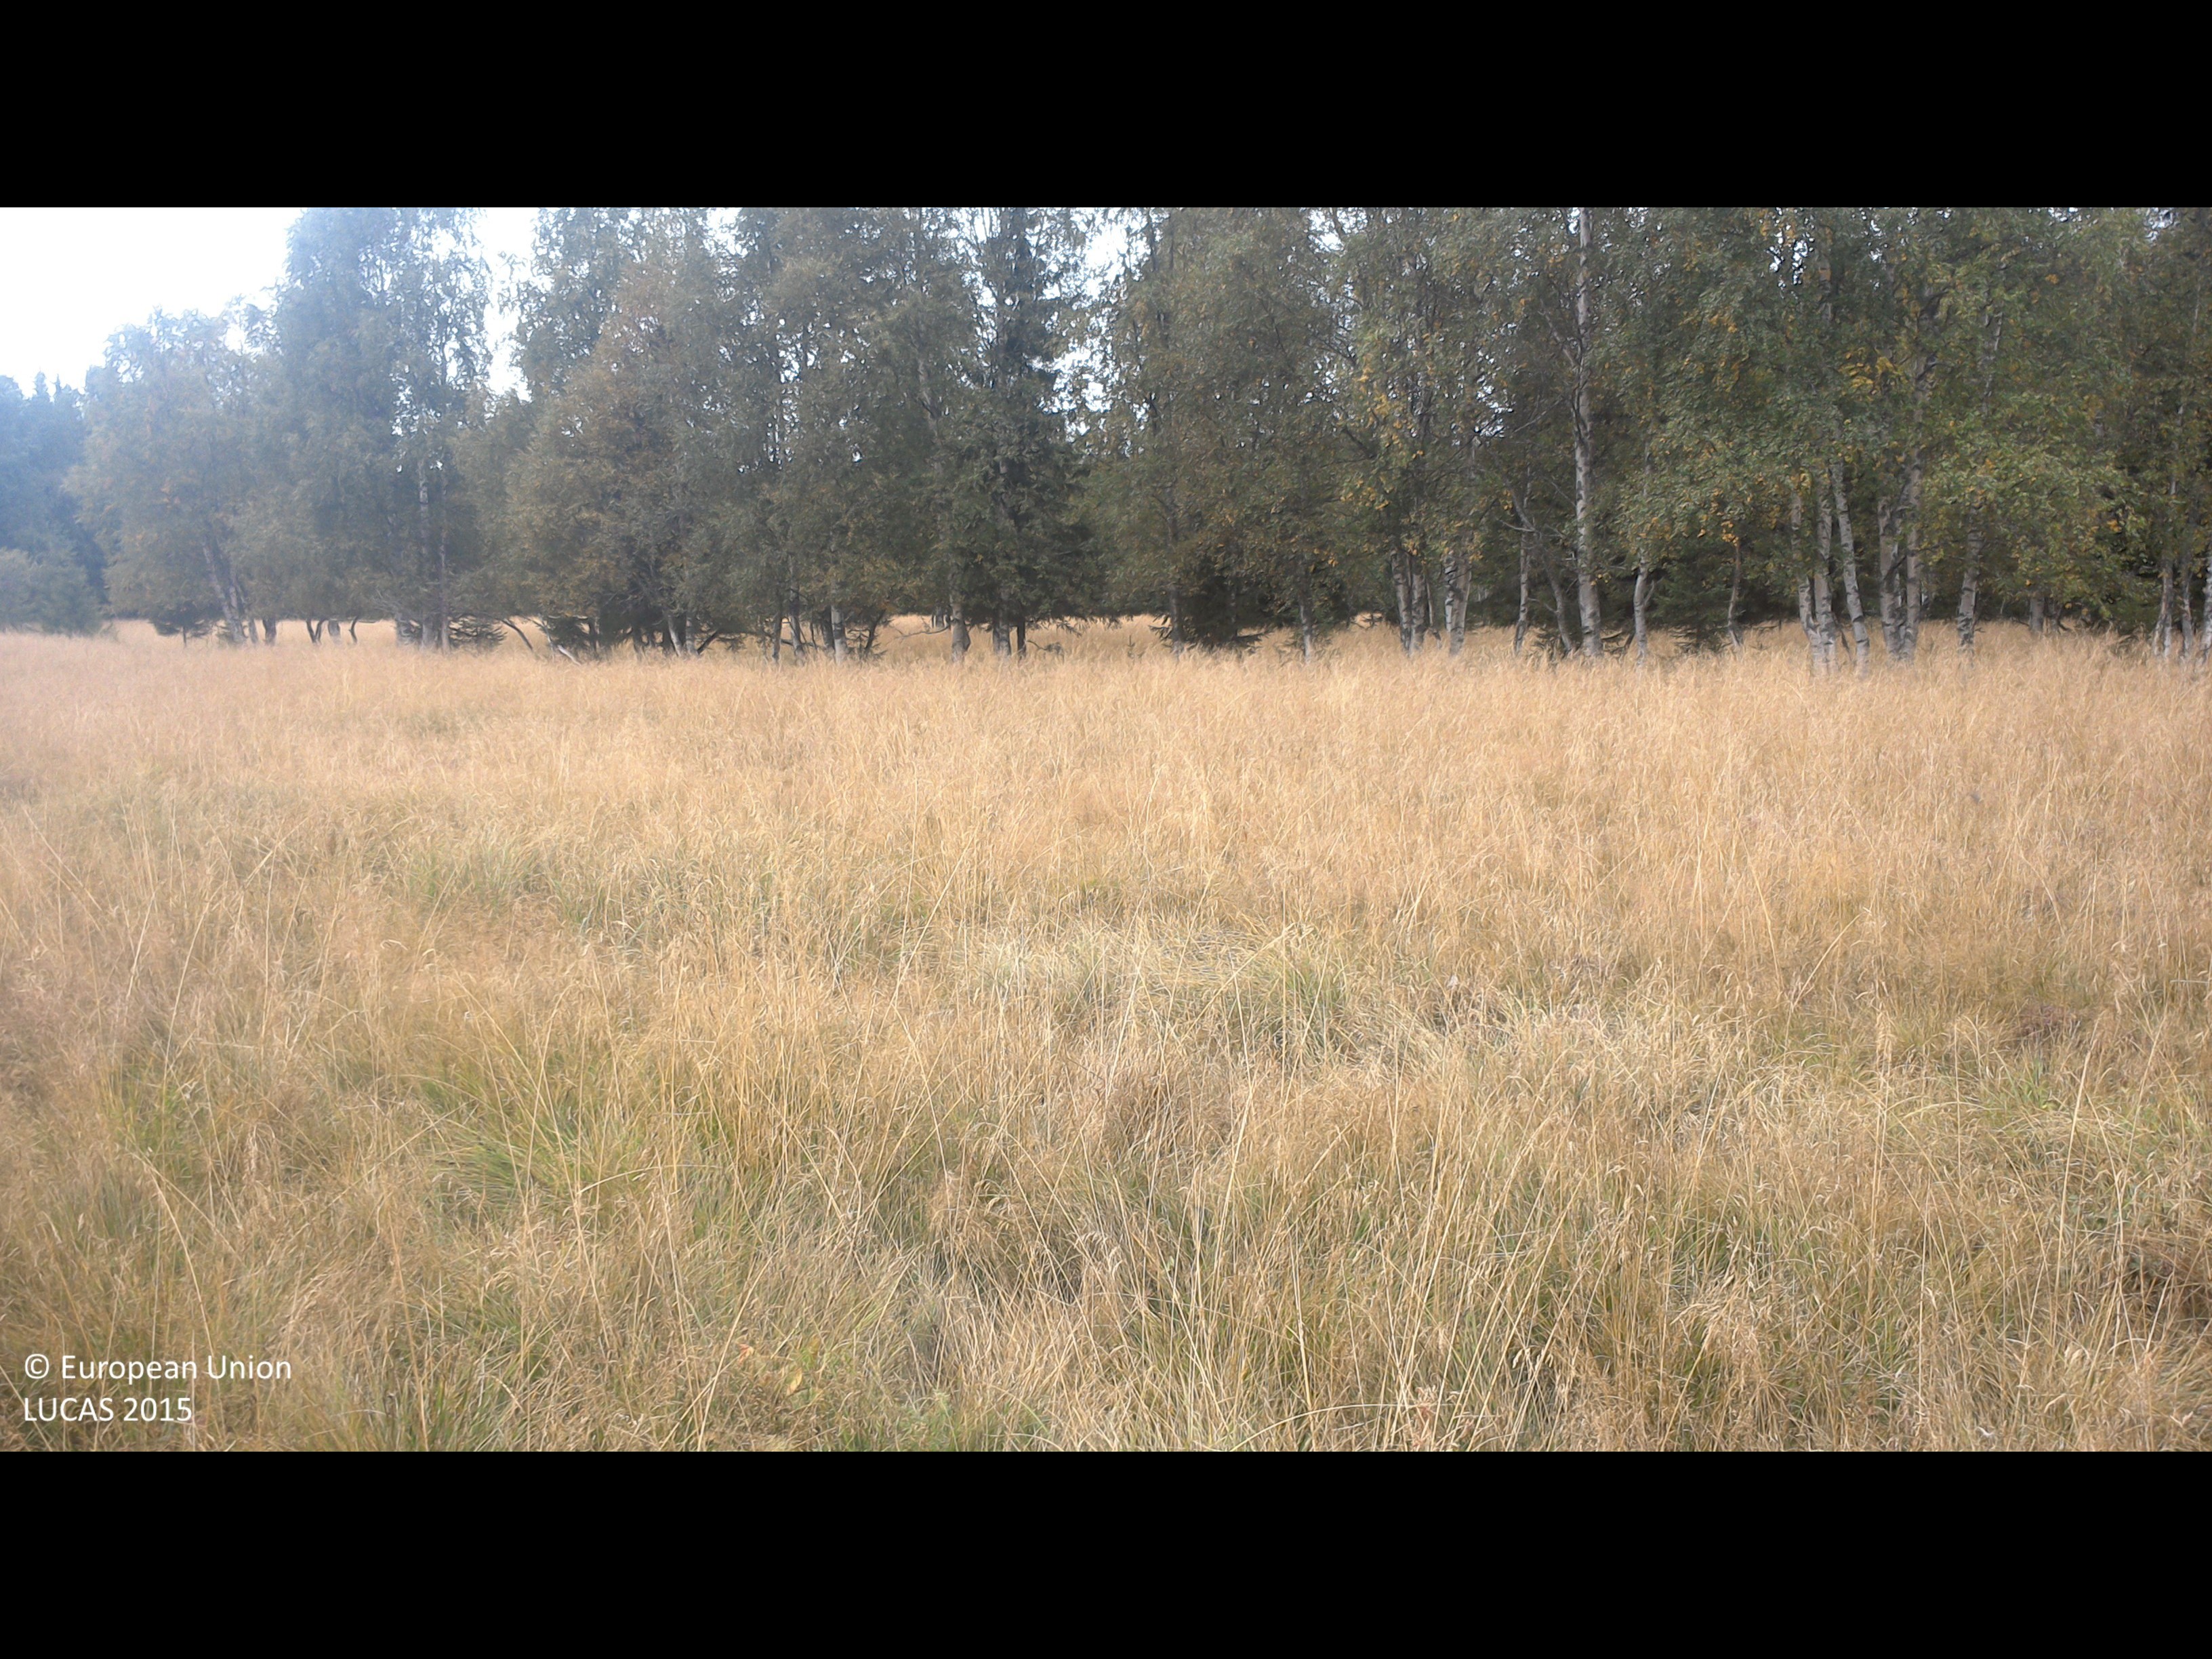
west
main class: Grassland
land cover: Grassland without tree/shrub cover
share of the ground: > 75 %
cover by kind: herbaceous plants 100 %
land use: Agriculture (excluding fallow land and kitchen gardens)
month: September
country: SE
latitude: 63.7807
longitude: 19.5739
